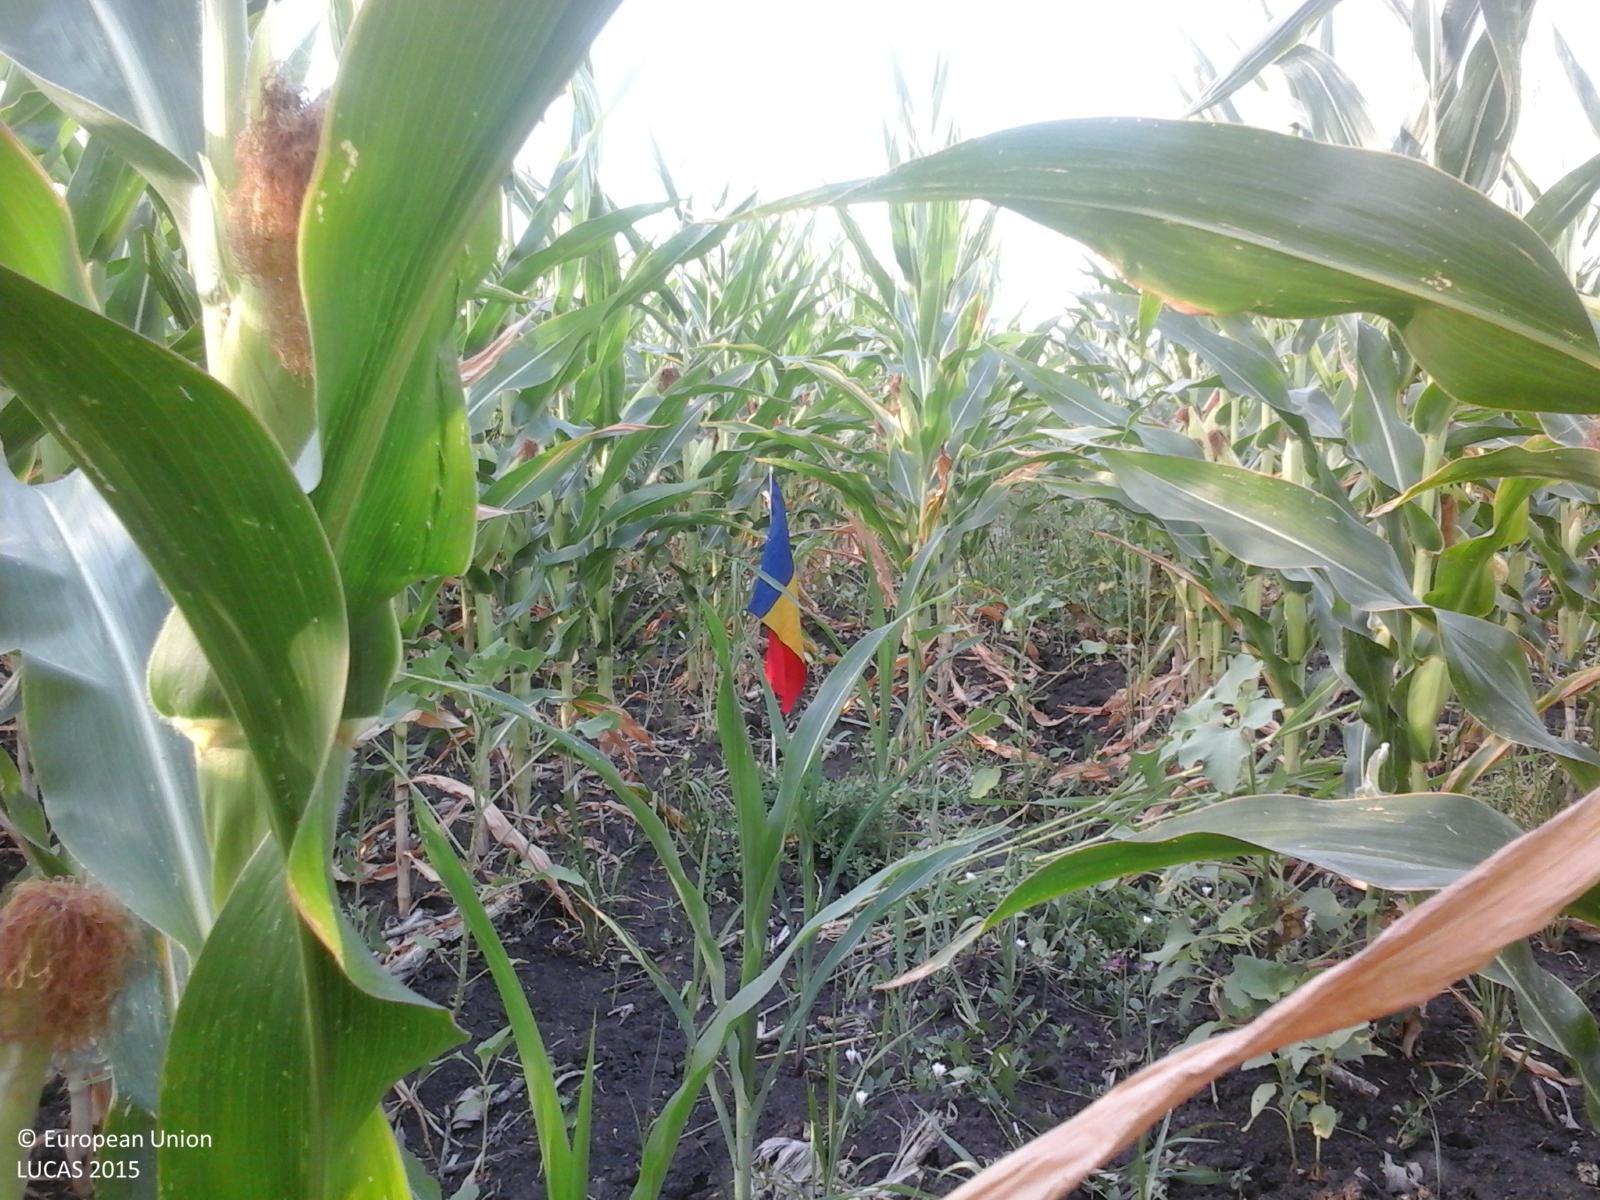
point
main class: Cropland
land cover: Maize
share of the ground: > 75 %
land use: Agriculture (excluding fallow land and kitchen gardens)
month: July
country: RO
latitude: 46.2181
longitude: 28.0543
